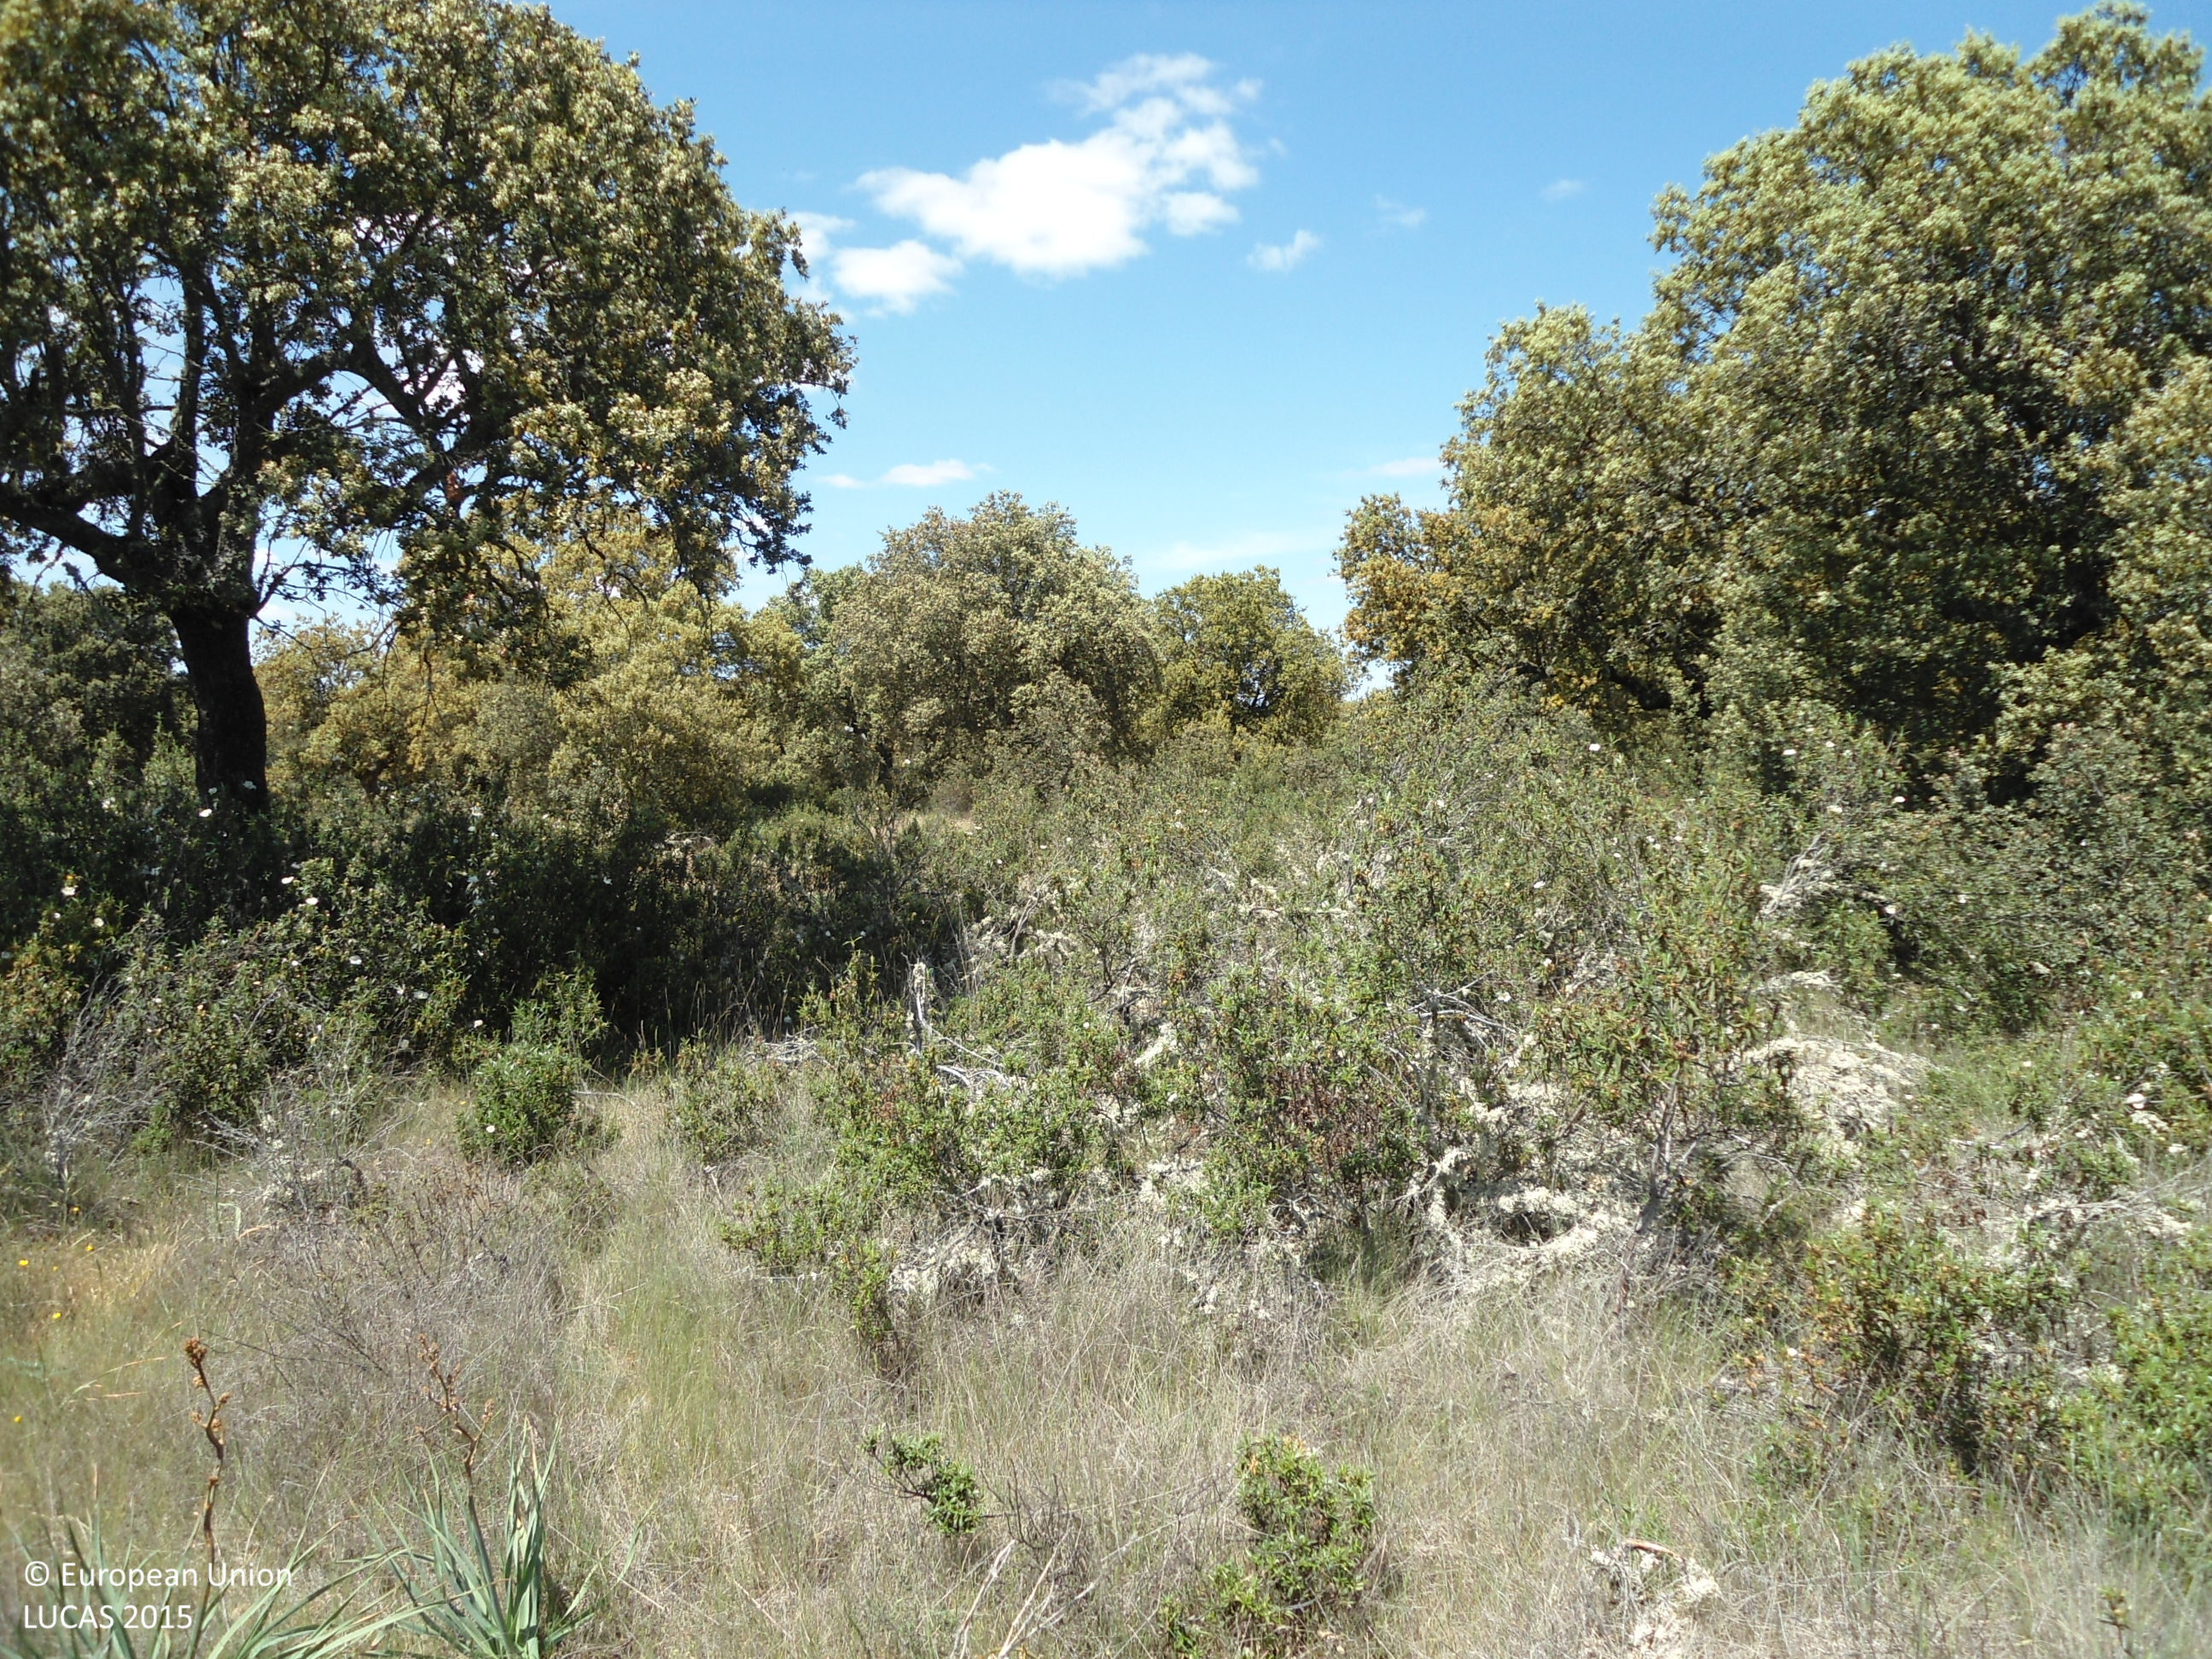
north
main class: Woodland
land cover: Broadleaved woodland
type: broadleaved evergreen forest
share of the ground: 50 - 75 %
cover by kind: broadleaved forest trees 60 %, shrubs 25 %, herbaceous plants 15 %
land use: Forestry
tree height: > 5 m
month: May
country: ES
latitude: 41.9385
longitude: -5.9080
